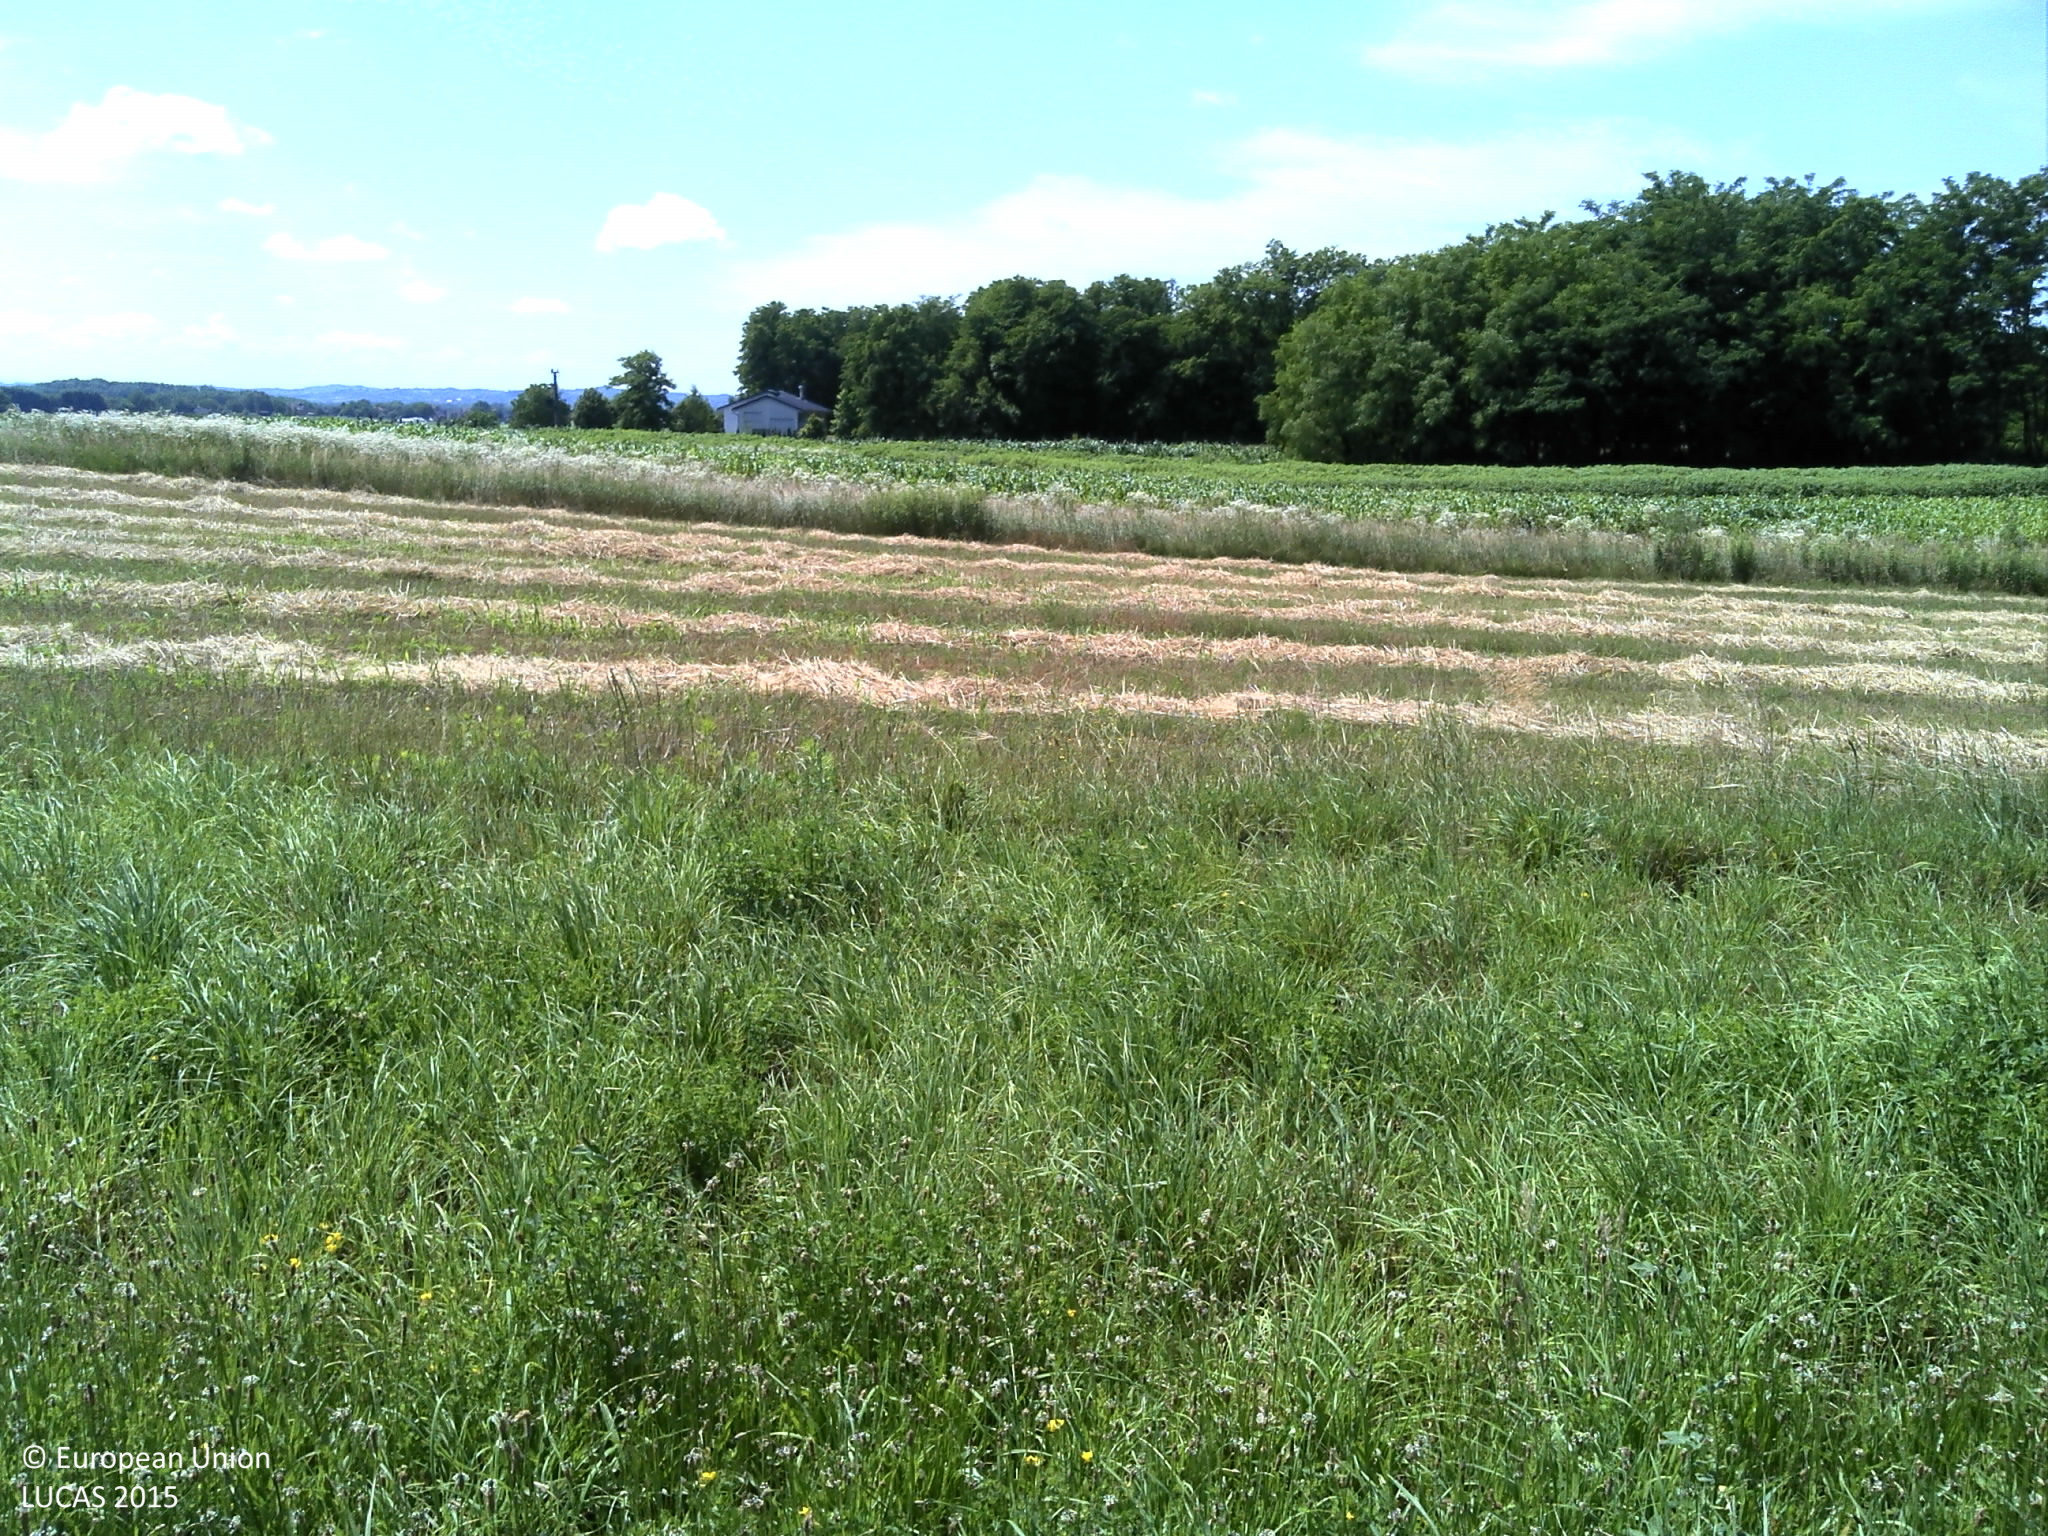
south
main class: Grassland
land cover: Spontaneously vegetated surfaces
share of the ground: > 75 %
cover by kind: herbaceous plants 100 %
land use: Semi-natural and natural areas not in use
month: June
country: HR
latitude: 45.9448
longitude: 17.2128
